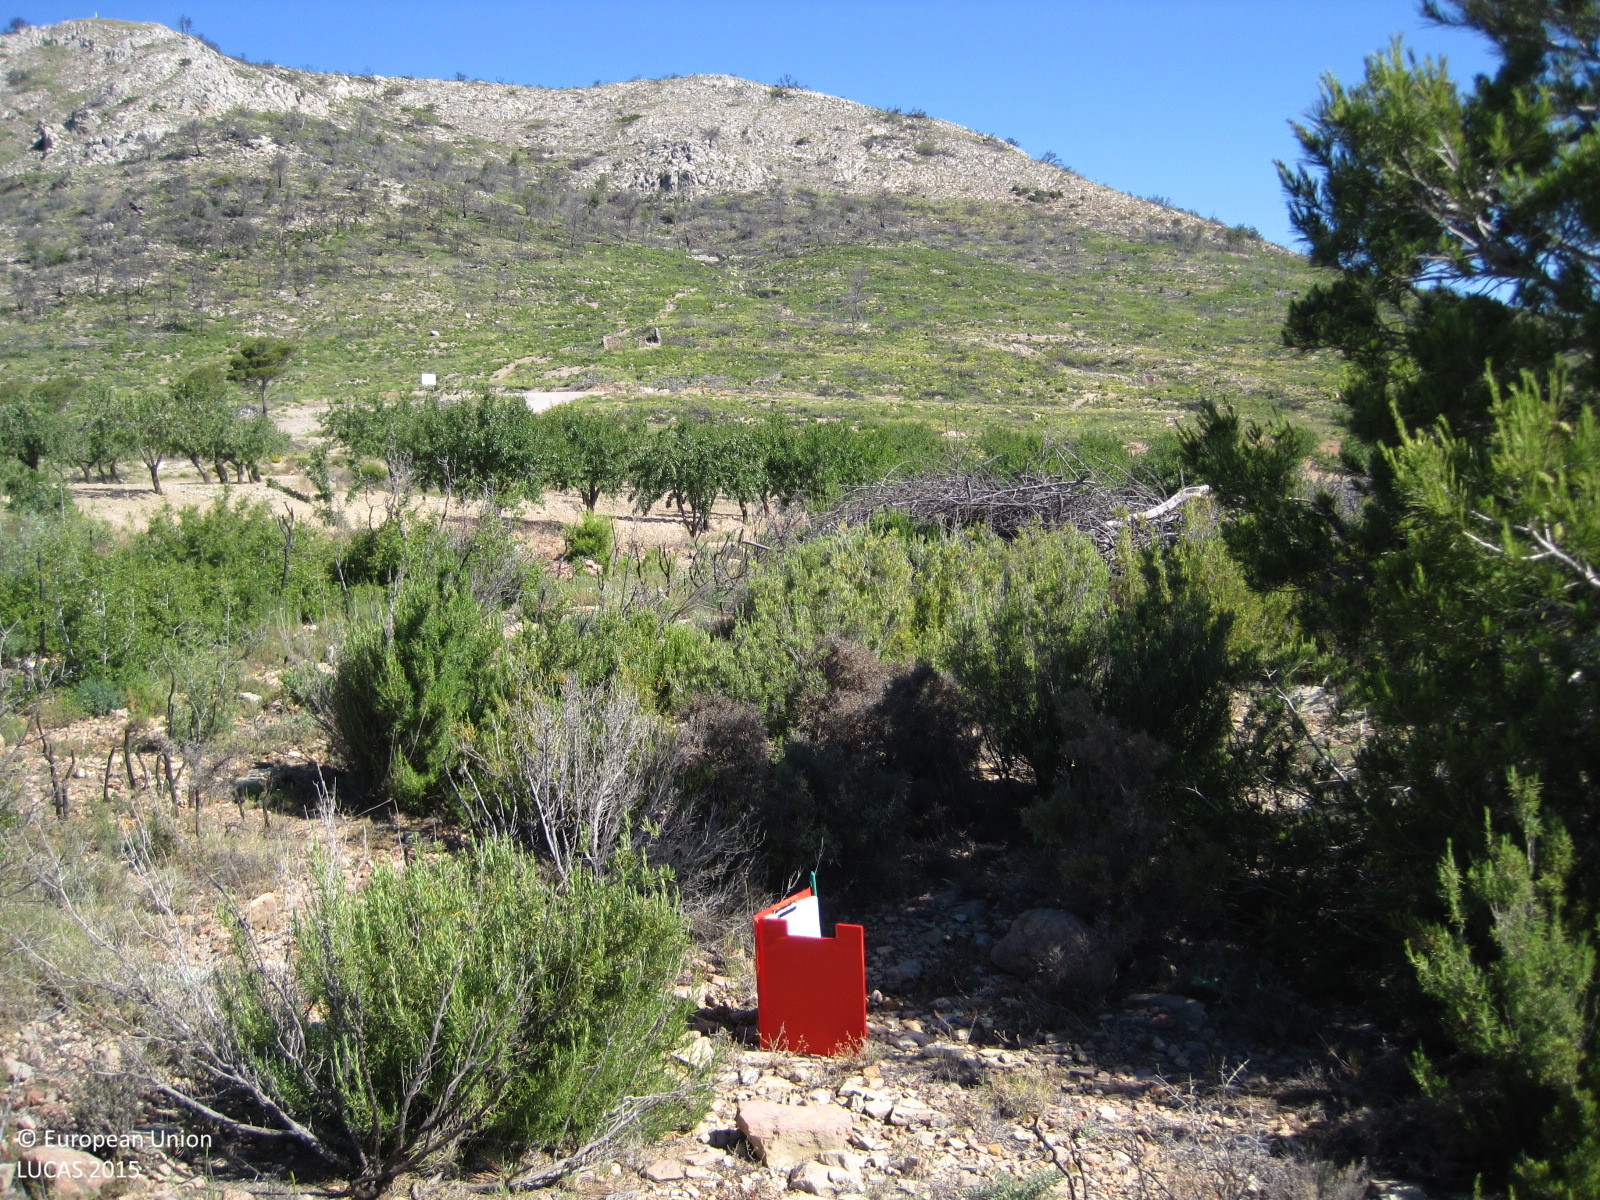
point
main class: Shrubland
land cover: Shrubland with sparse tree cover
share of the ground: 50 - 75 %
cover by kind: shrubs 60 %, consolidated bare surface 25 %, herbaceous plants 10 %, coniferous forest trees 5 %
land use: Semi-natural and natural areas not in use
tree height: > 5 m
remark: Burnt area
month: May
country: ES
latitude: 39.7759
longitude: -0.6614
